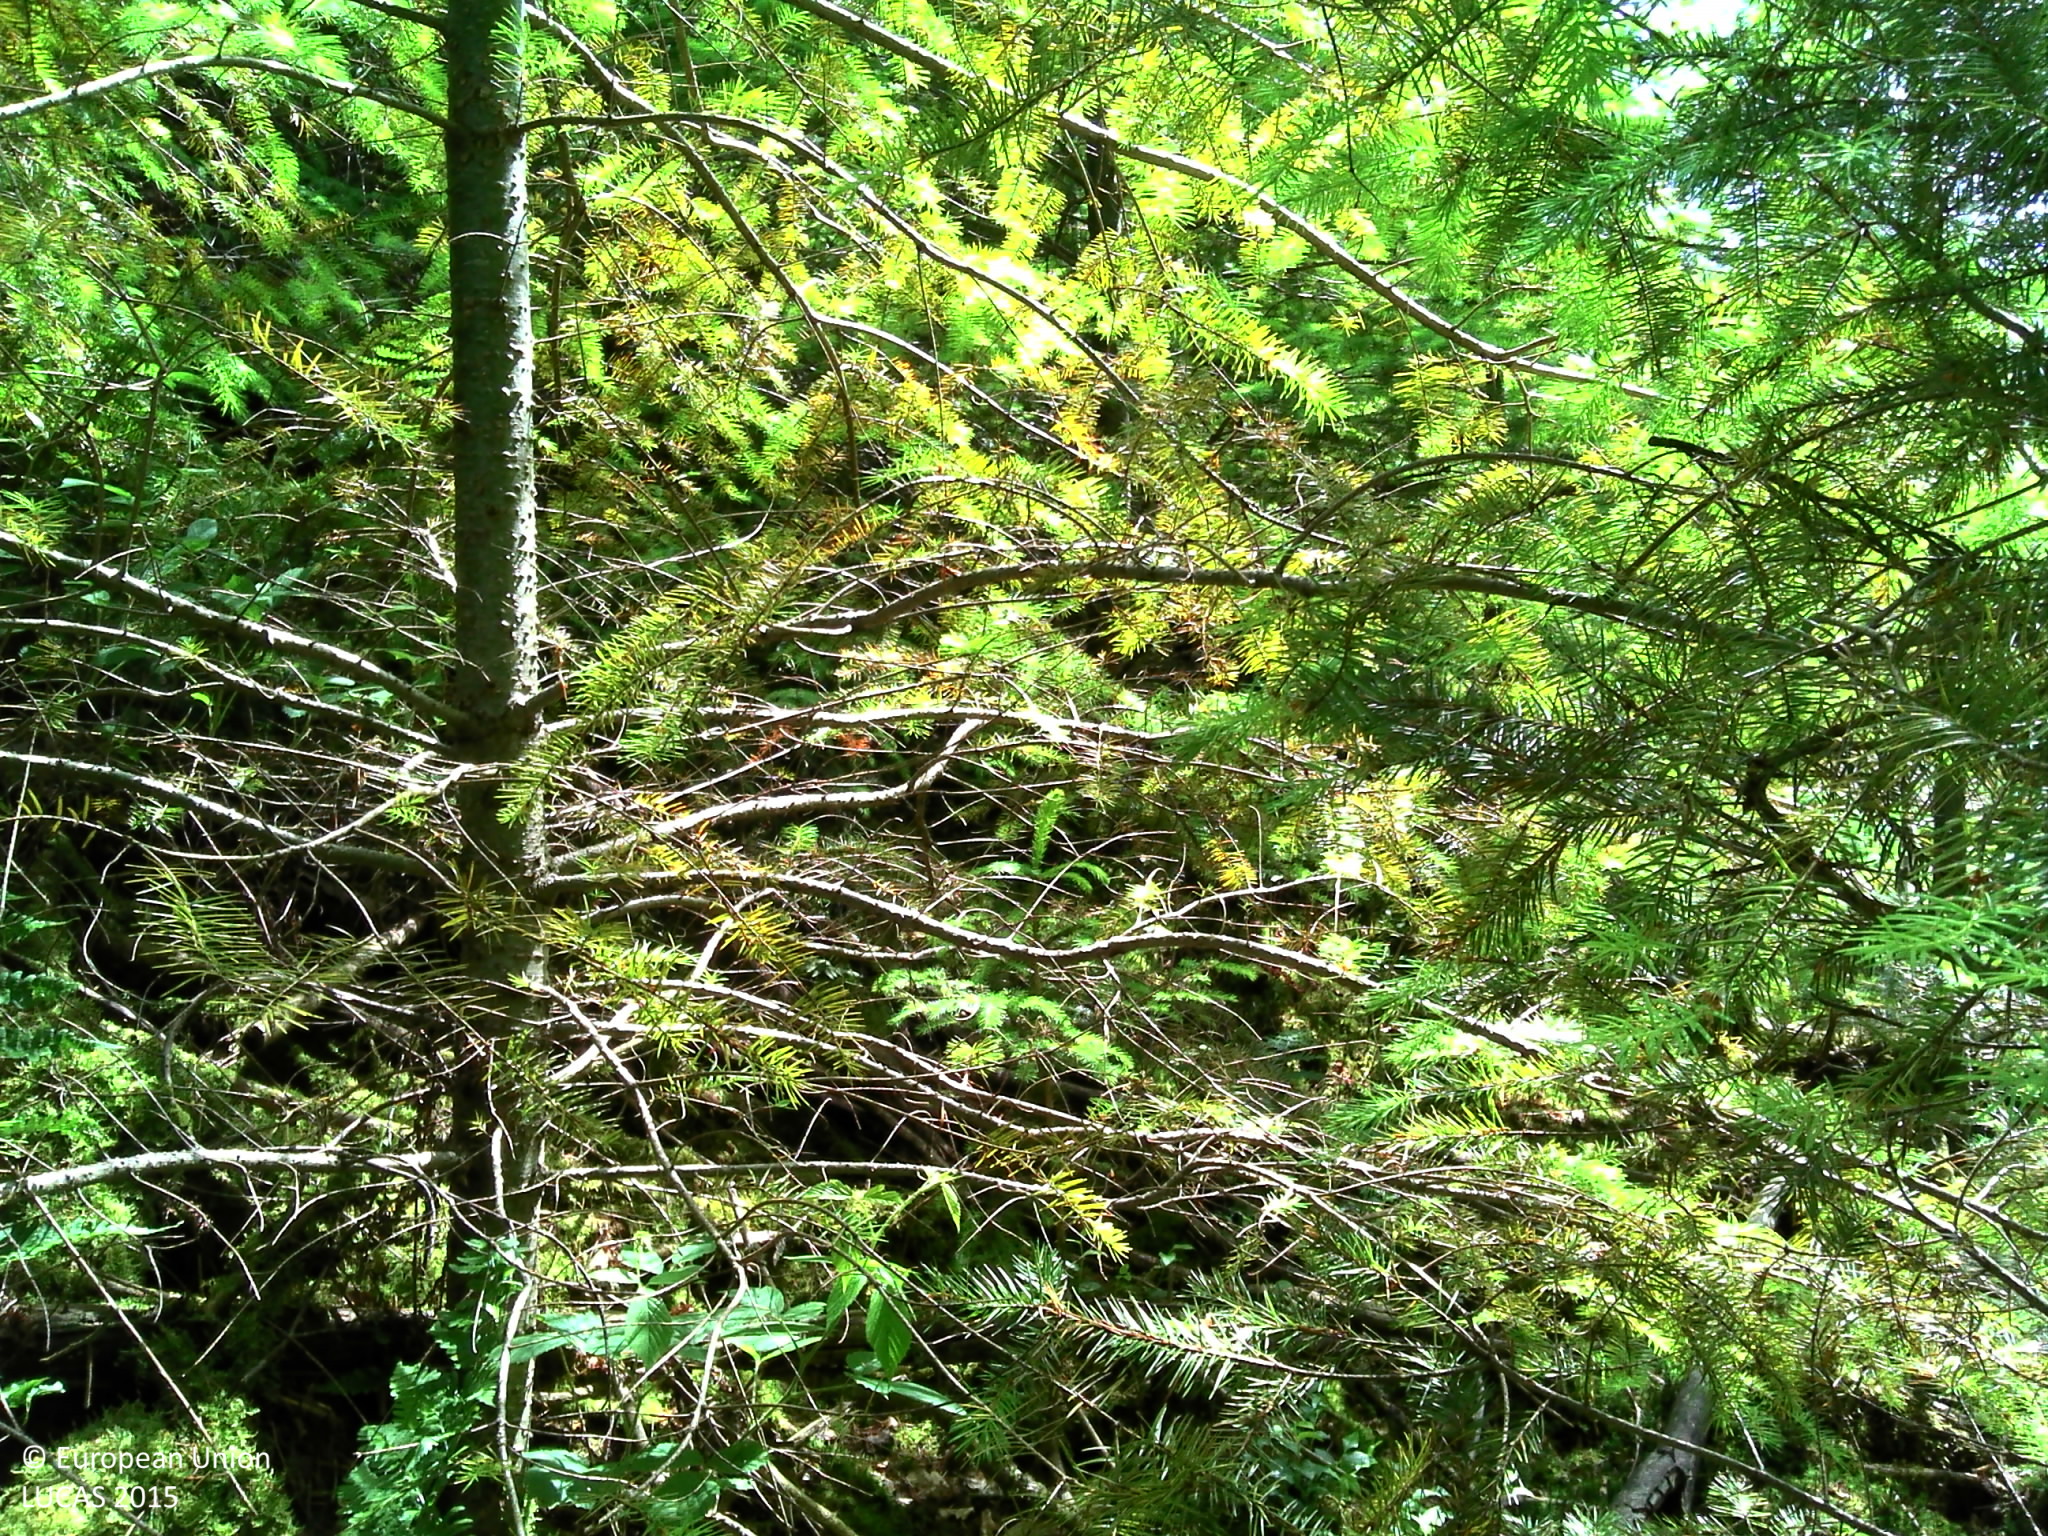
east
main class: Woodland
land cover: Other coniferous woodland
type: exotic forest
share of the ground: > 75 %
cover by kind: coniferous forest trees 90 %, broadleaved forest trees 5 %, shrubs 5 %
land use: Forestry
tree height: > 5 m
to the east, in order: Other coniferous woodland; Broadleaved woodland; Other coniferous woodland; Broadleaved woodland; Tracks; Grass margins; Abandoned hedges; Spruce dominated coniferous woodland; Broadleaved woodland
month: June
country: BE
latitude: 50.0319
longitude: 5.2653
